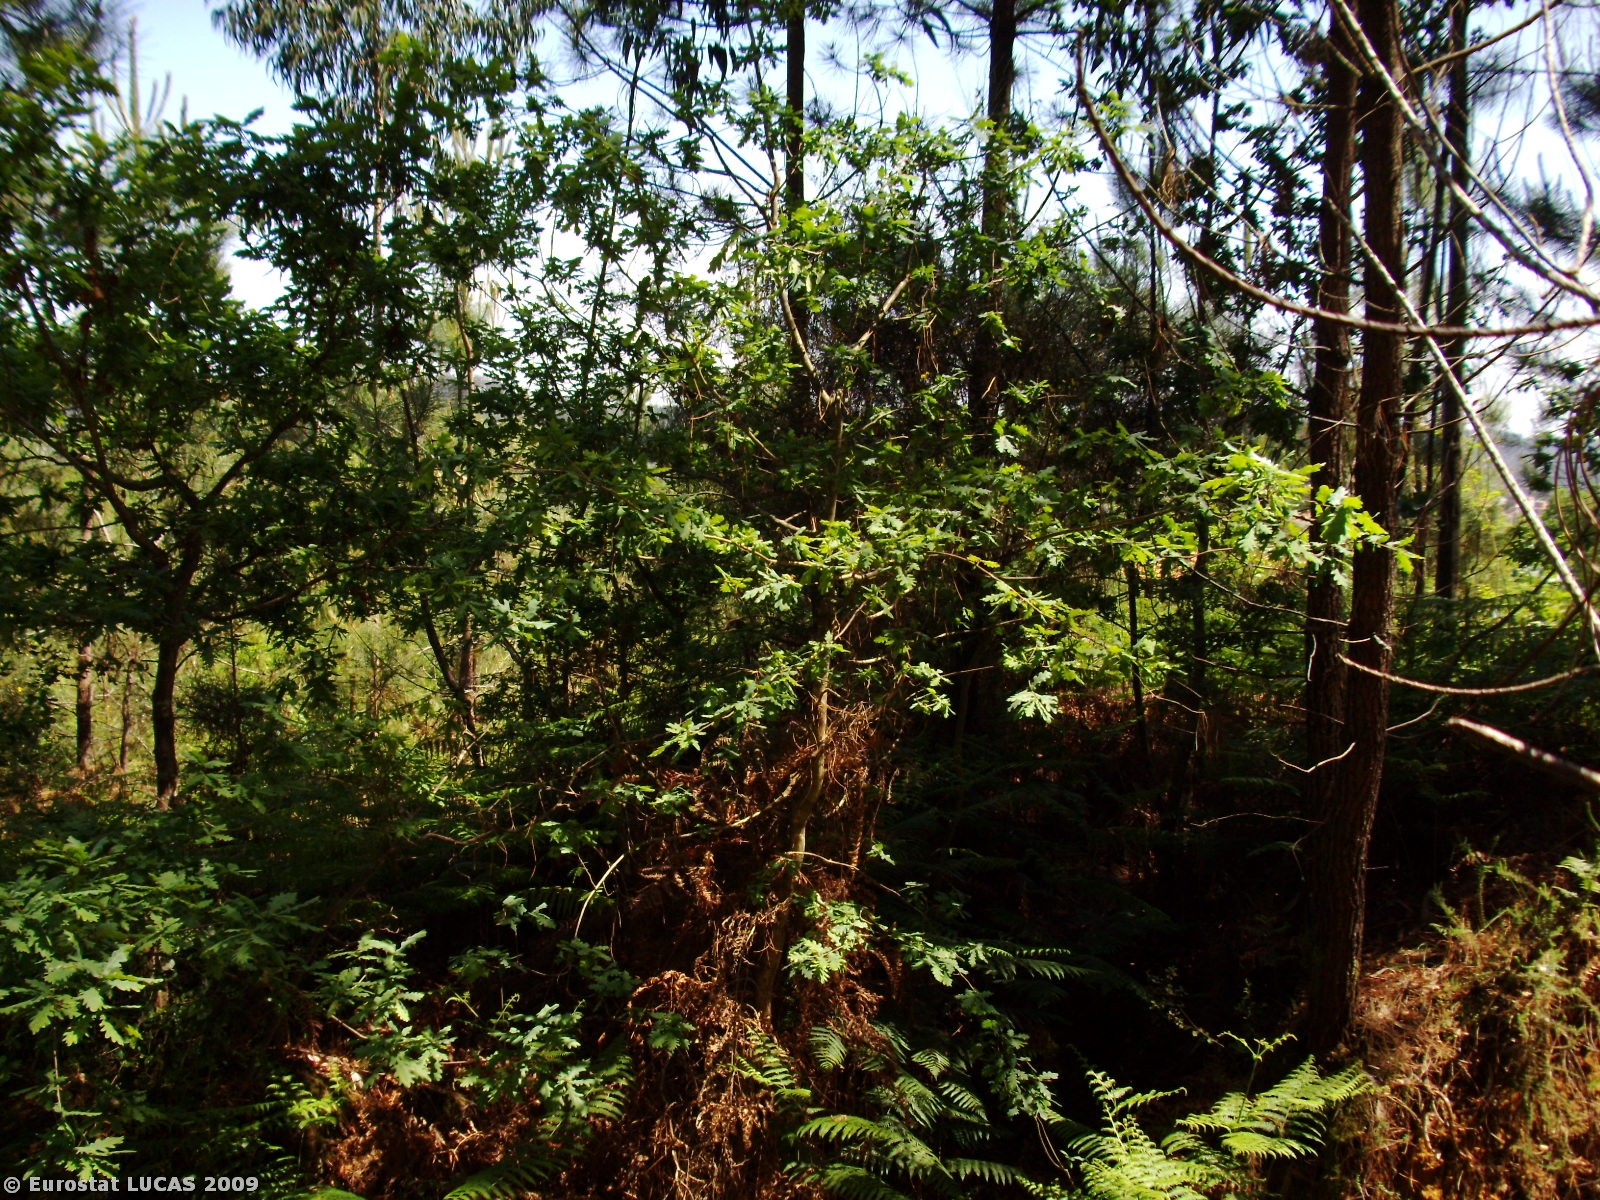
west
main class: Woodland
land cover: Broadleaved woodland
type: plantations and self-sown exotic forest
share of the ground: 50 - 75 %
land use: Forestry
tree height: > 5 m
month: May
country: PT
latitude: 41.6843
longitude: -8.6270
